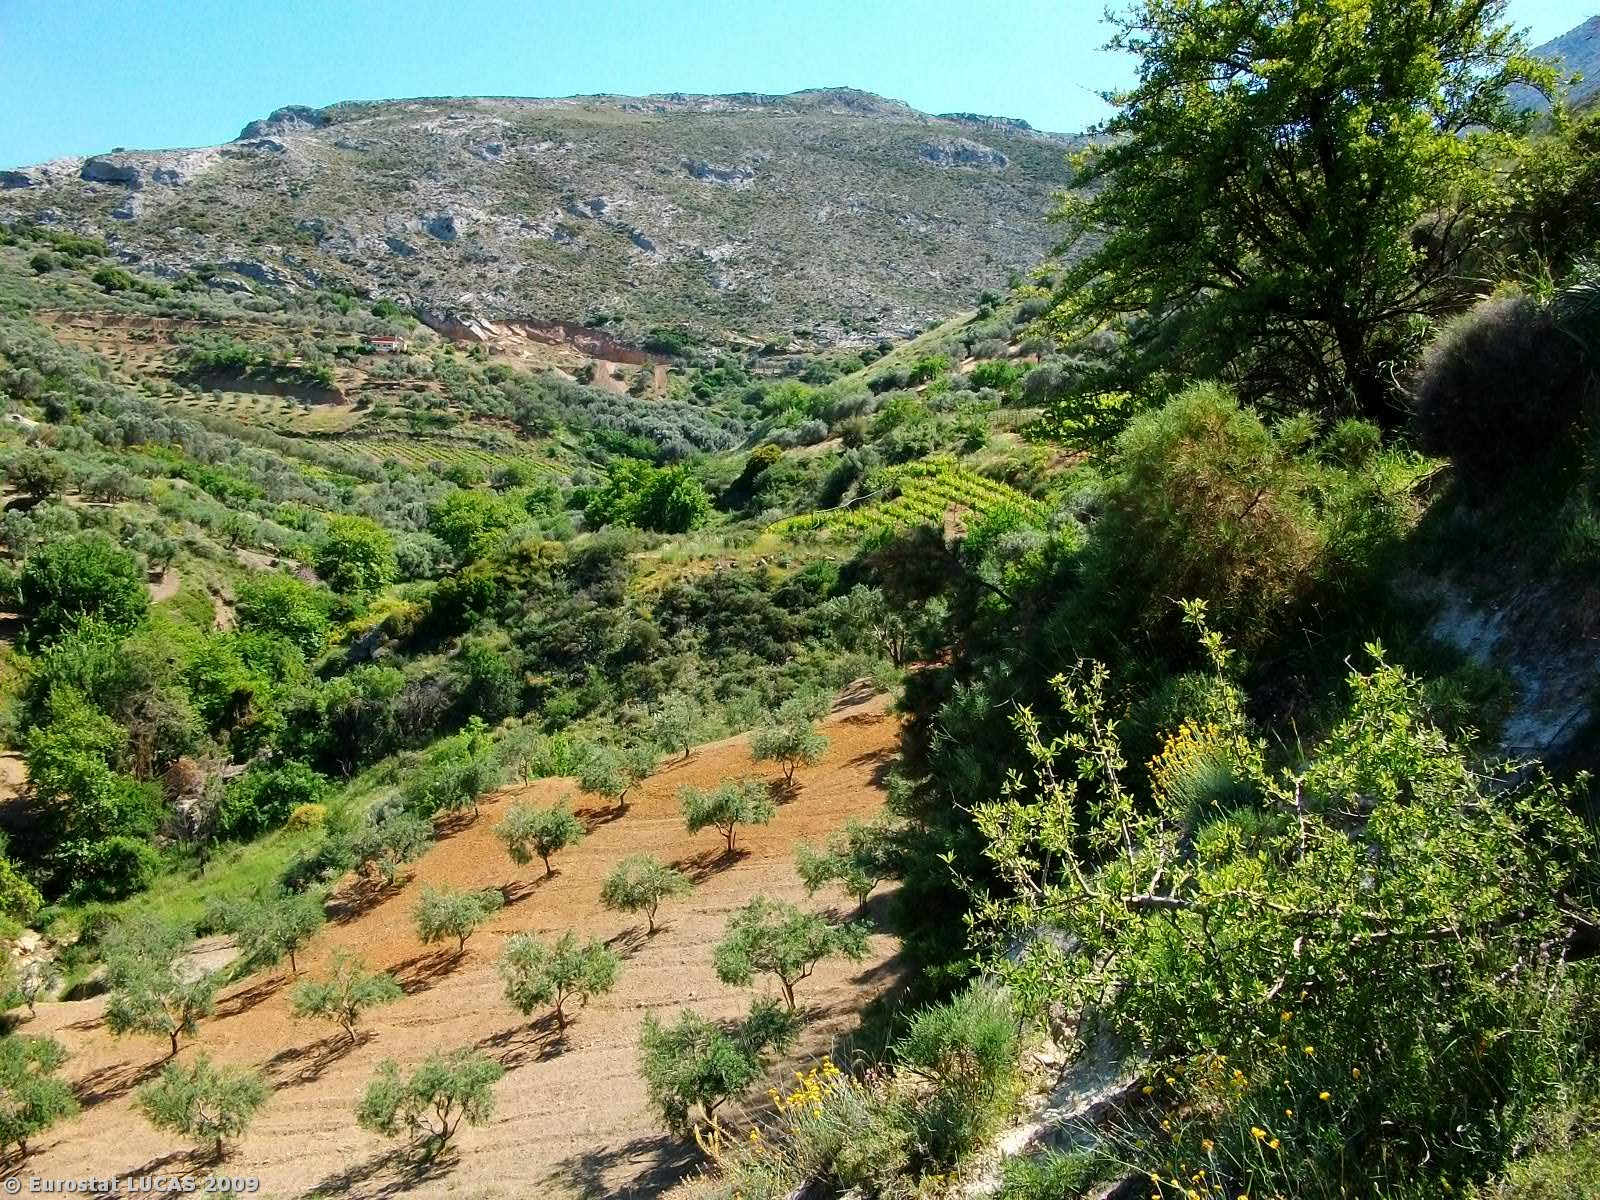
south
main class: Shrubland
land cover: Shrubland with sparse tree cover
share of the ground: 50 - 75 %
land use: Unused
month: May
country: GR
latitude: 35.2082
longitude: 24.9831
